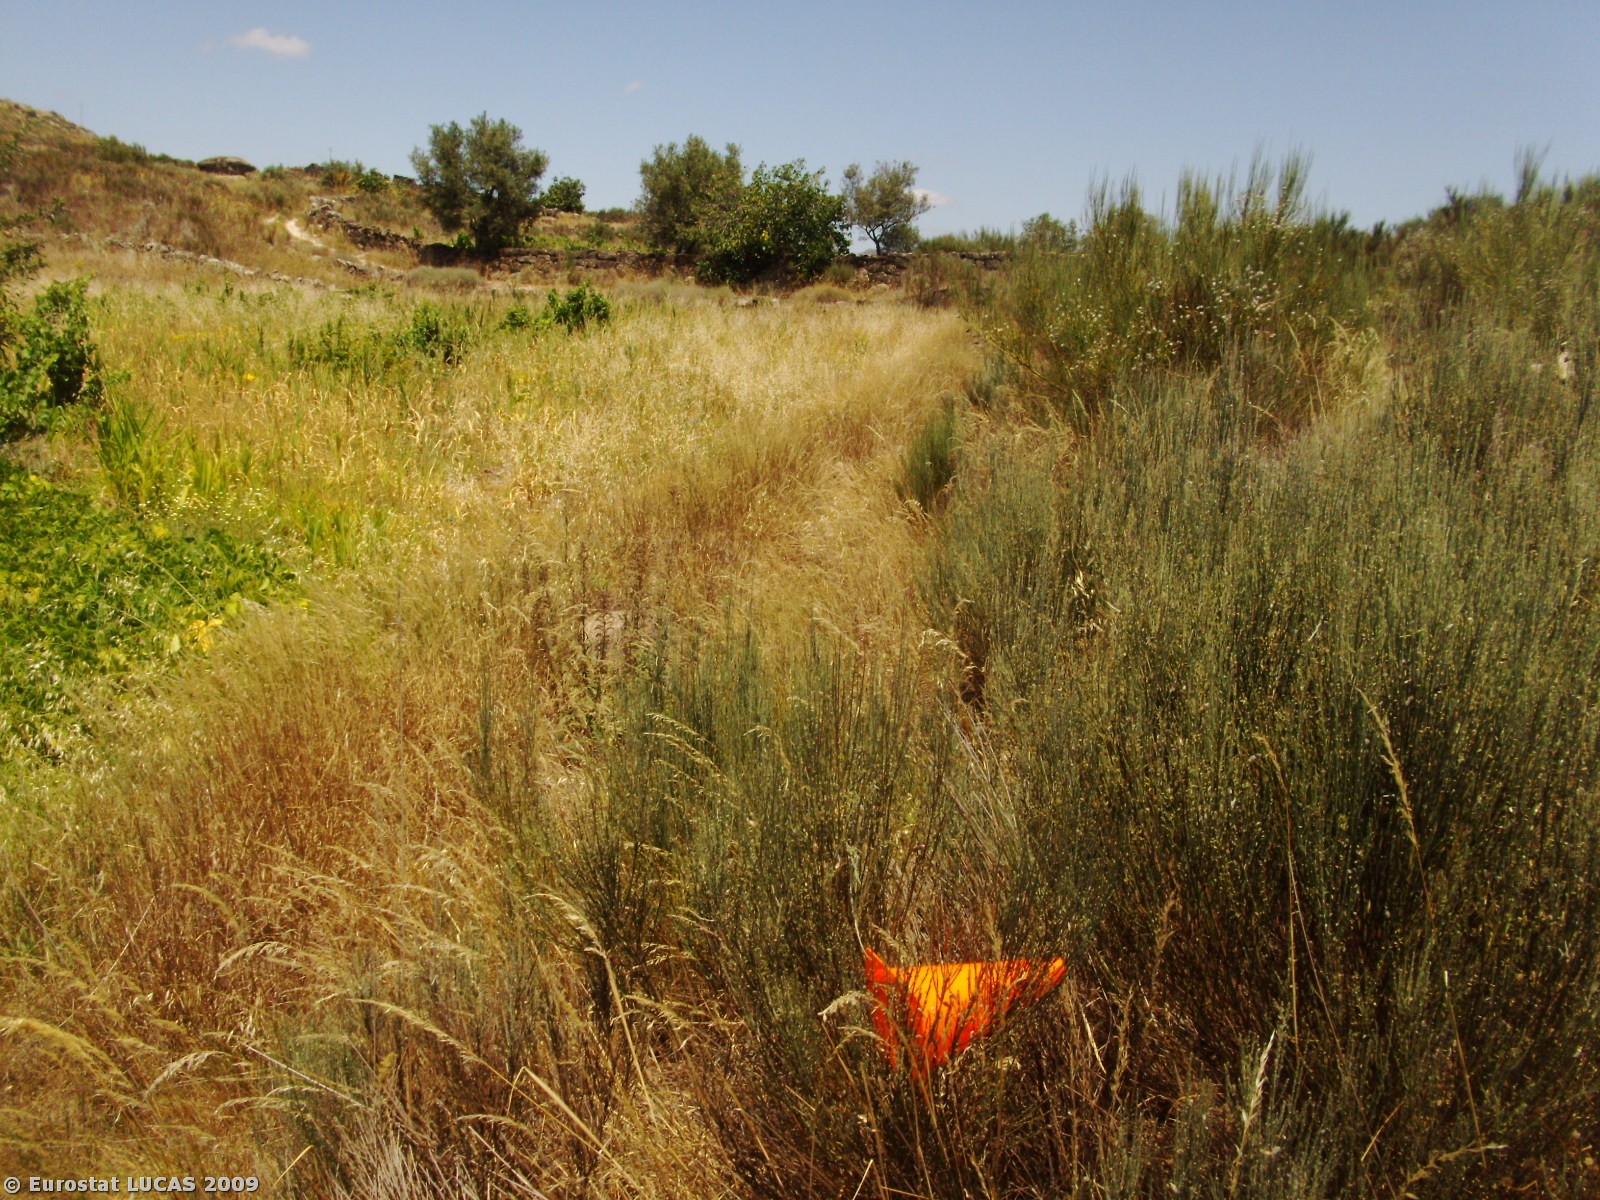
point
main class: Shrubland
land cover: Shrubland without tree cover
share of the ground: > 75 %
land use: Unused
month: July
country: PT
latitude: 40.3351
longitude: -7.2283
